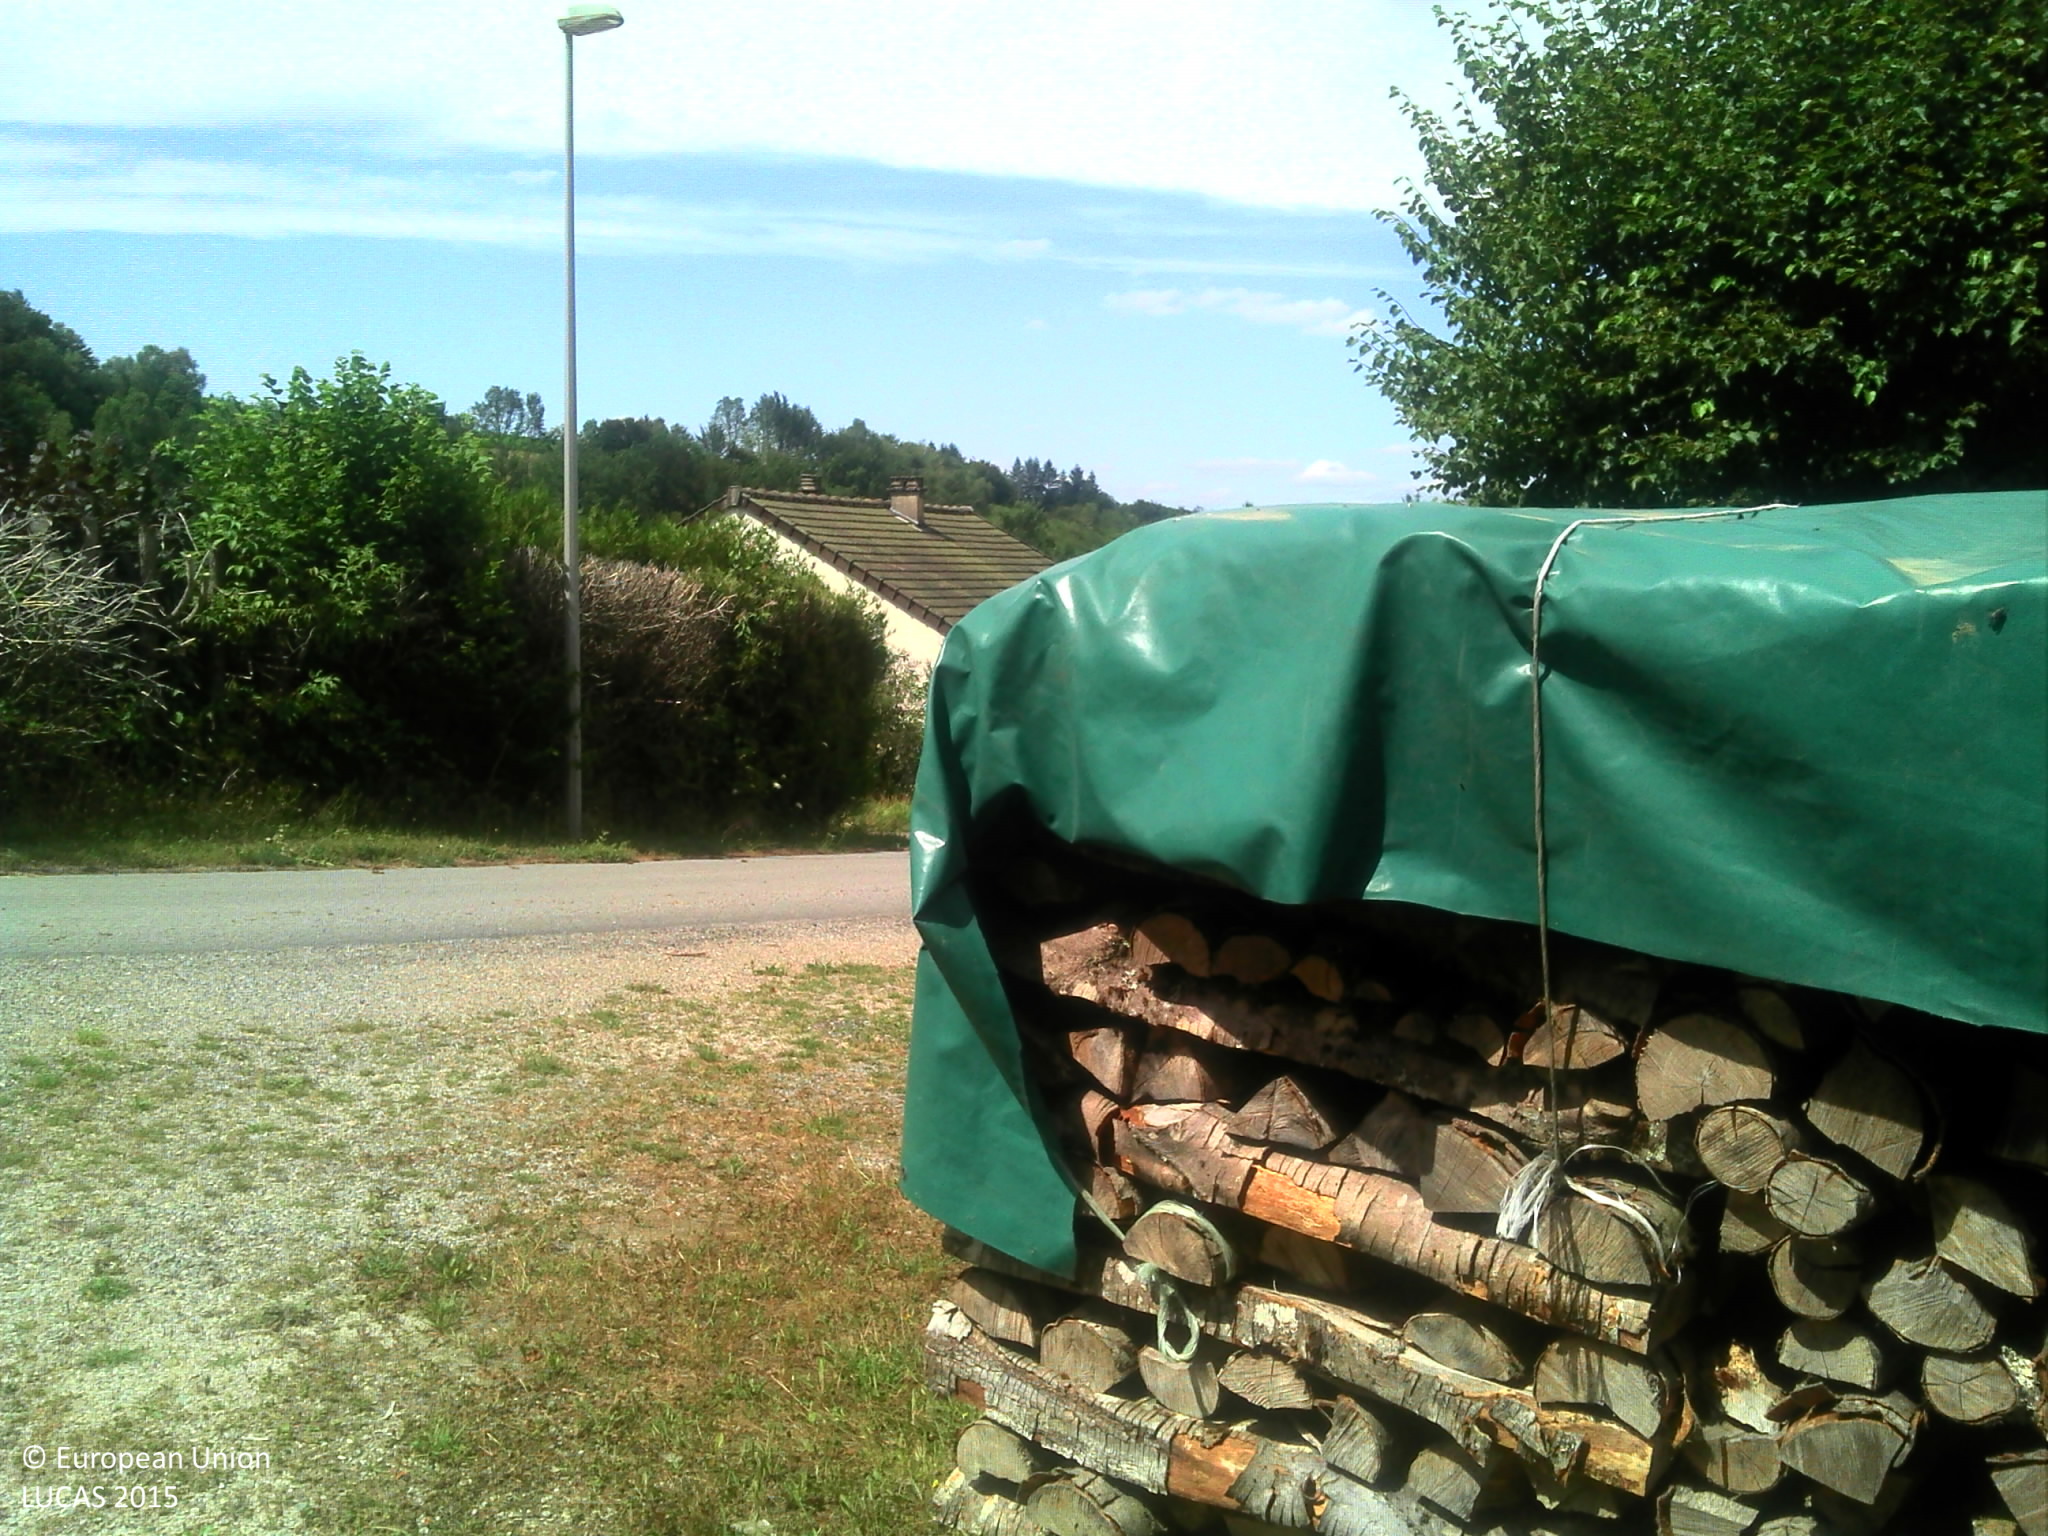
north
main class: Grassland
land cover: Grassland without tree/shrub cover
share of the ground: > 75 %
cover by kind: herbaceous plants 95 %, shrubs 5 %
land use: Forestry
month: July
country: FR
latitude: 45.6395
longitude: 1.8225
